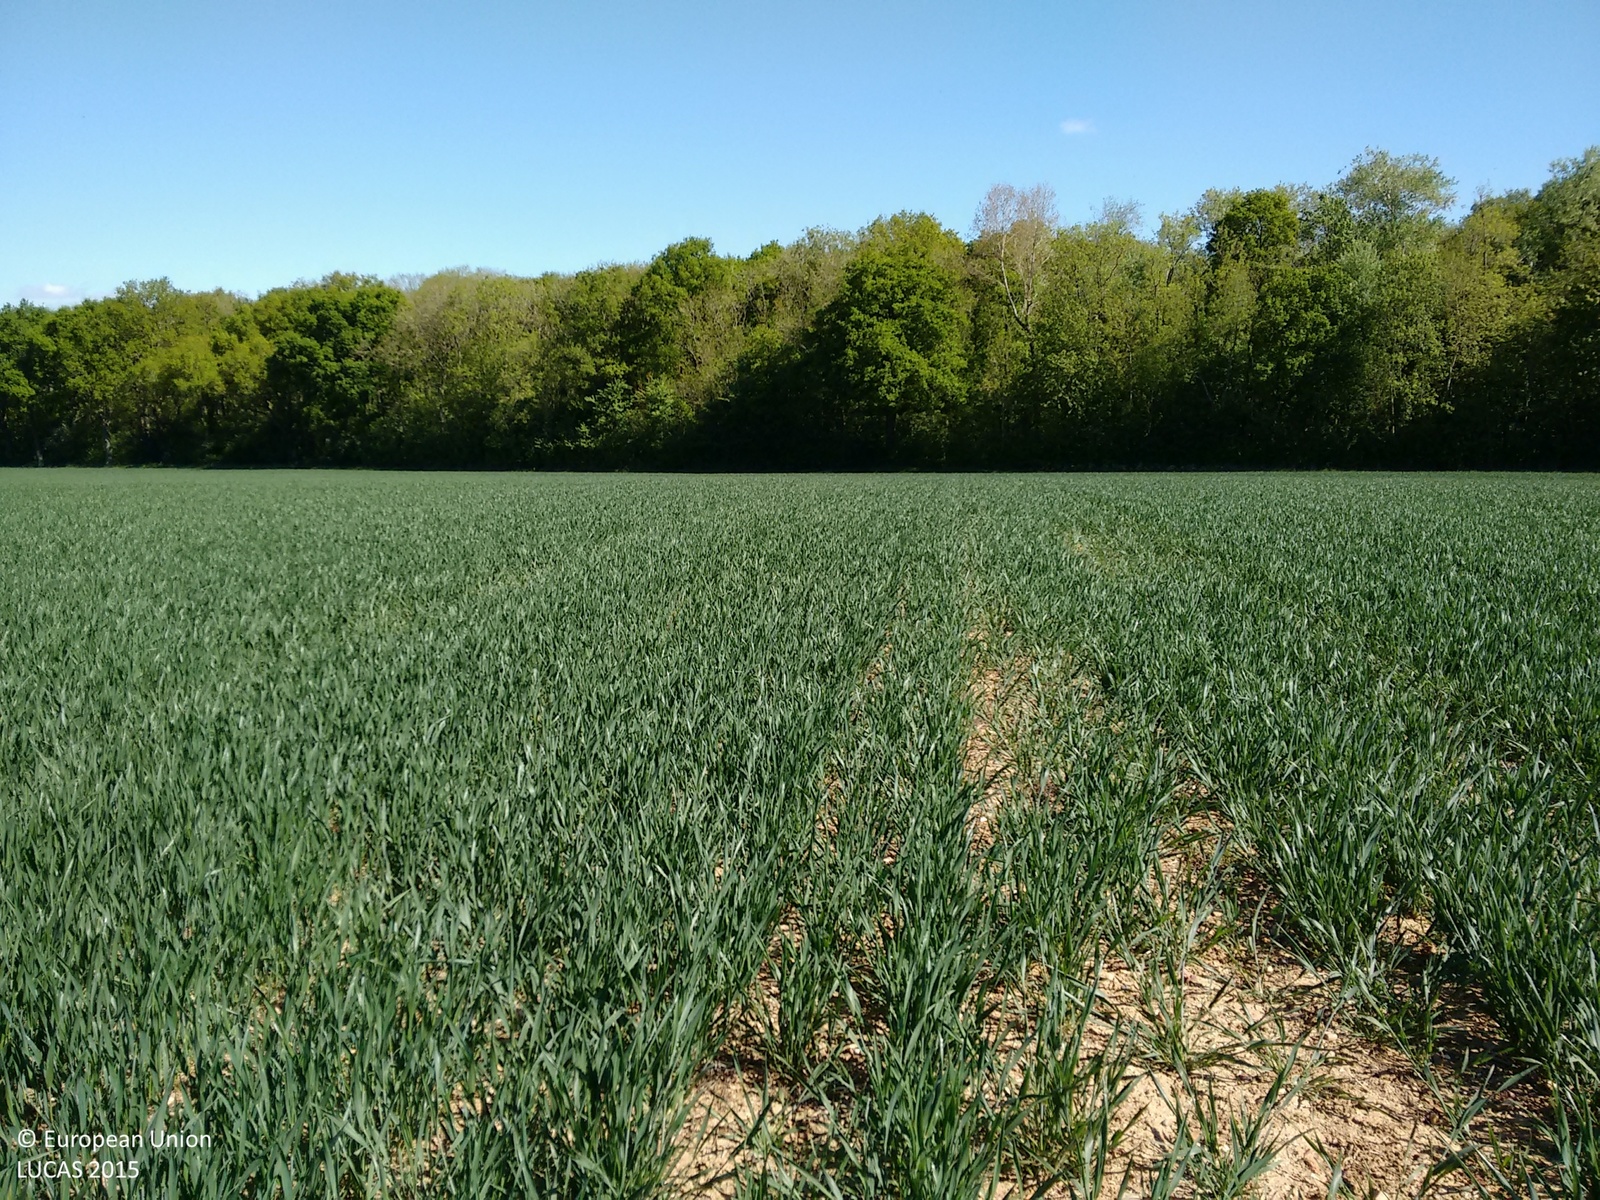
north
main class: Cropland
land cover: Common wheat
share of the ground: 50 - 75 %
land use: Agriculture (excluding fallow land and kitchen gardens)
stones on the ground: < 10 %
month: May
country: GB
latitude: 51.3030
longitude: -0.9885
